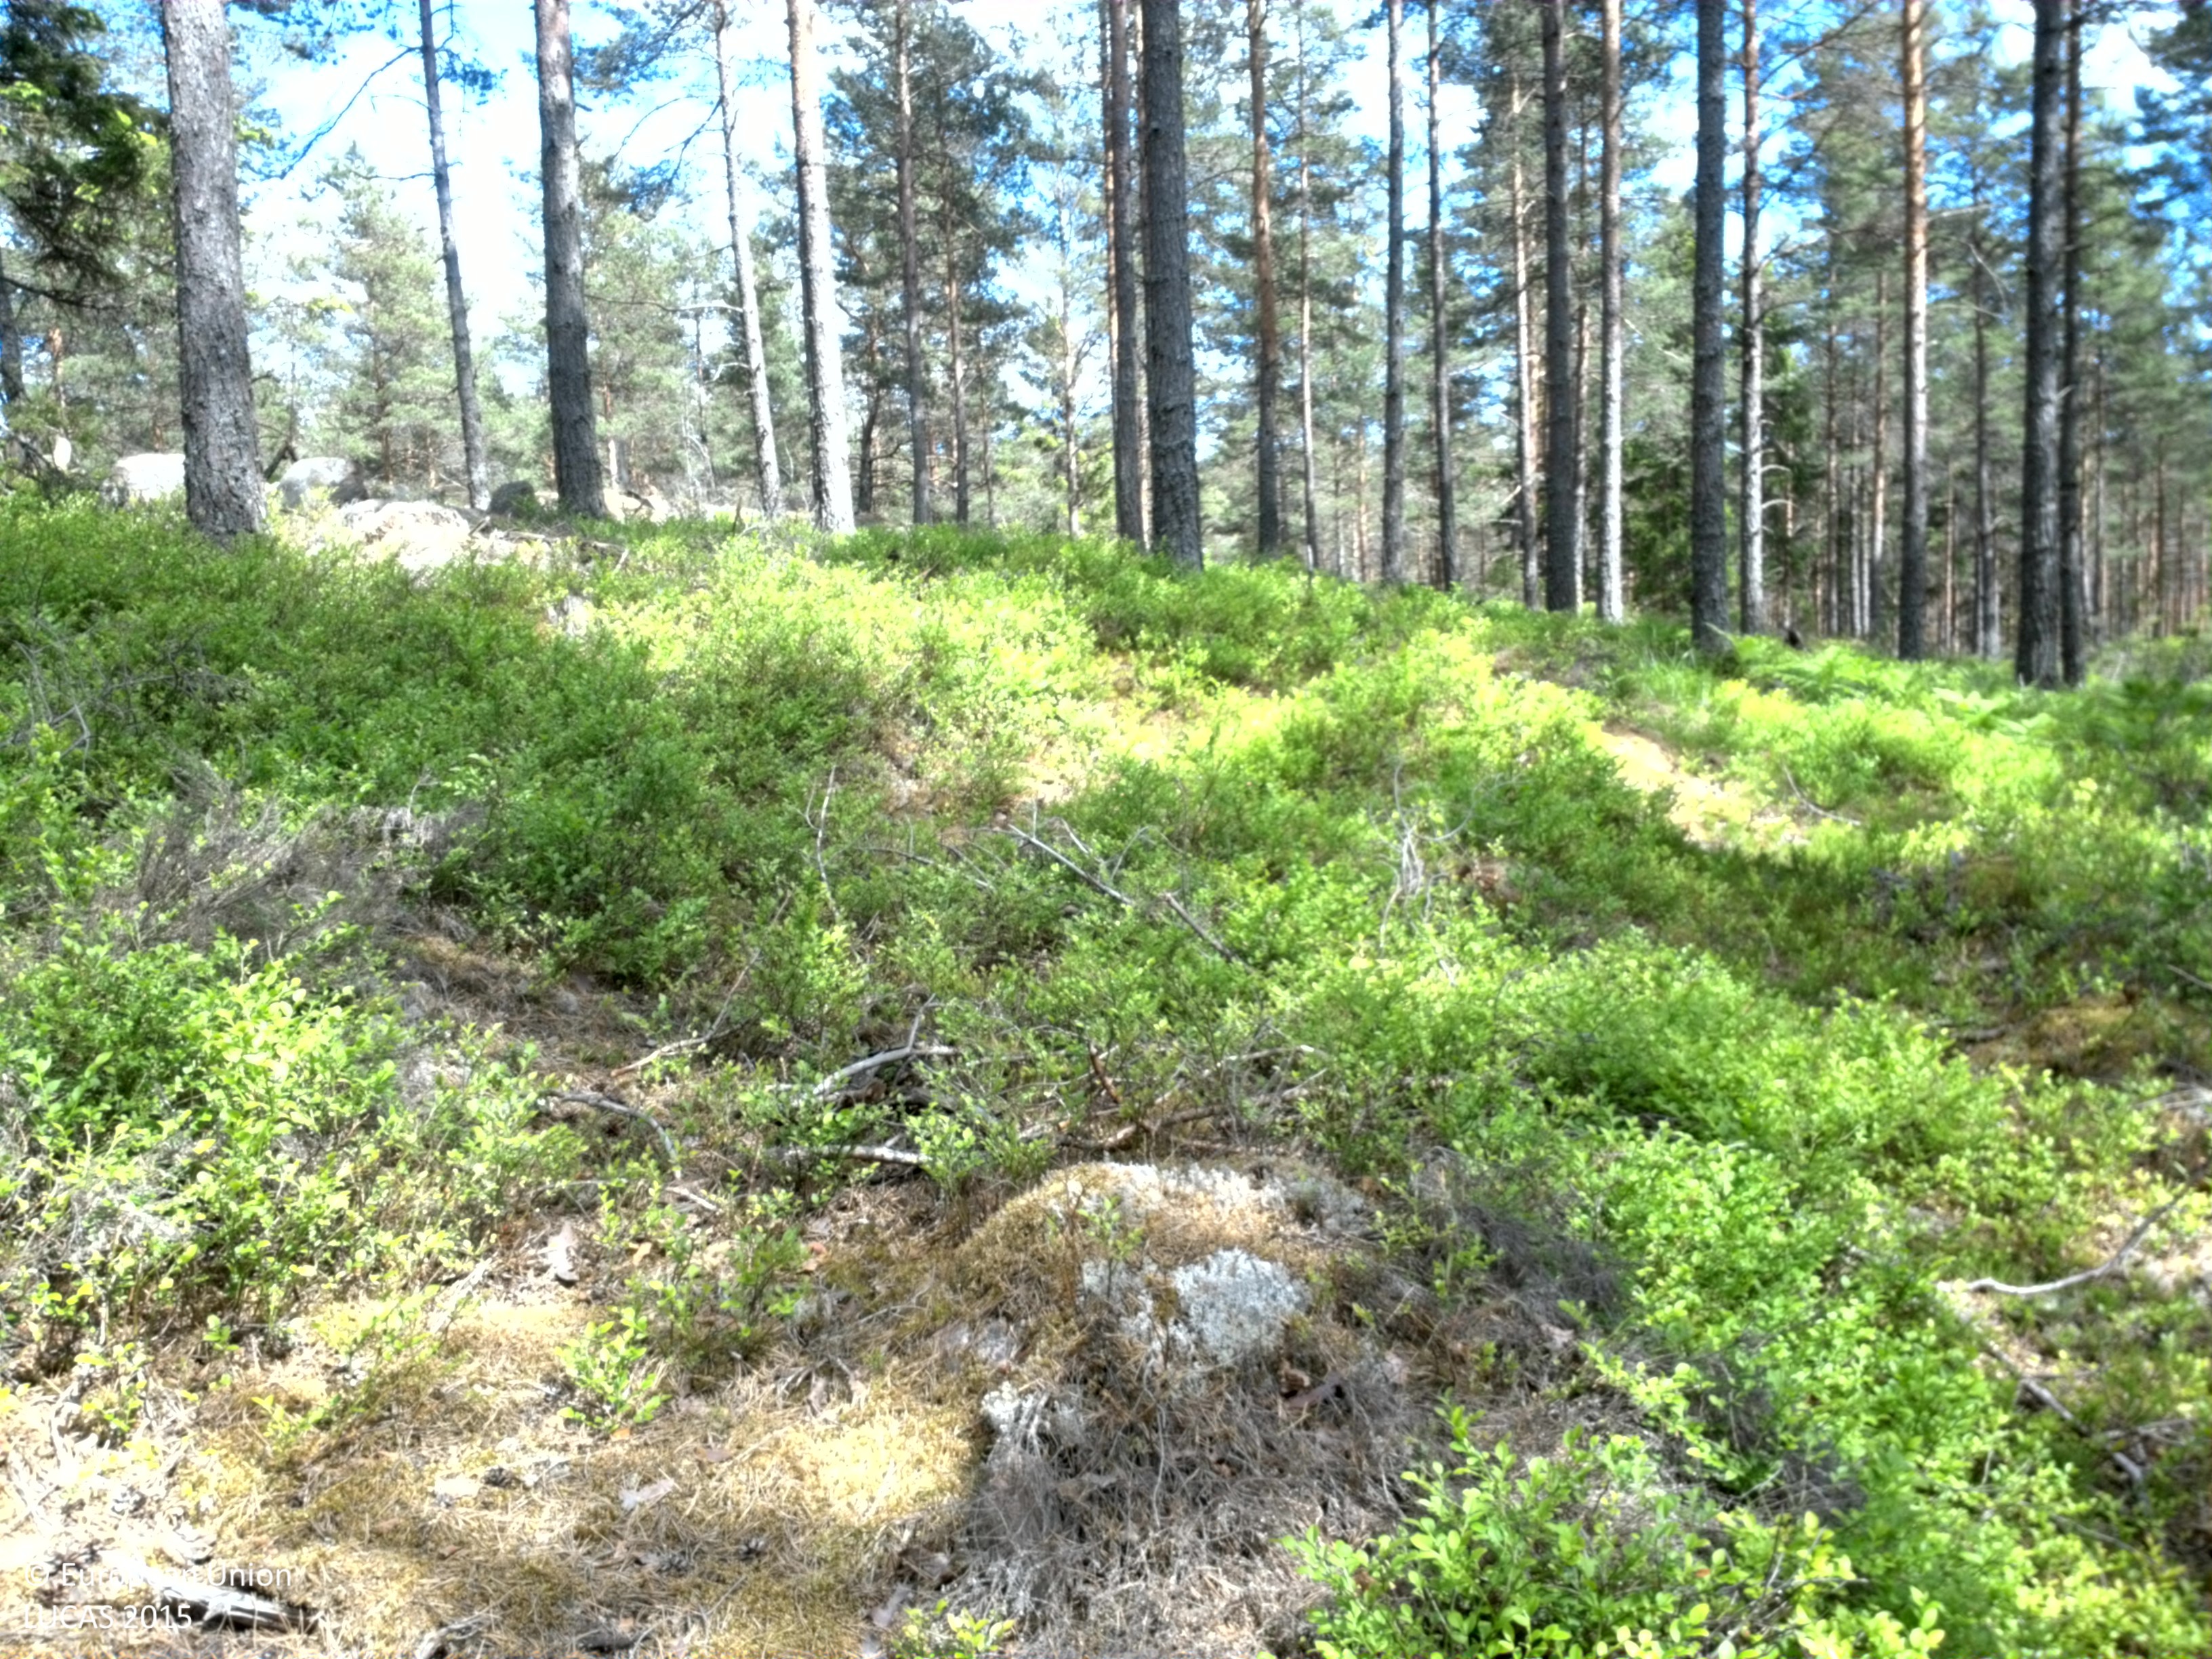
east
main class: Woodland
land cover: Pine dominated coniferous woodland
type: boreal forest
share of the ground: 10 - 25 %
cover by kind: herbaceous plants 40 %, lichens and mosses 40 %, coniferous forest trees 20 %
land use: Forestry
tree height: > 5 m
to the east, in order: Pine dominated coniferous woodland; Rivers and streams; Pine dominated coniferous woodland
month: June
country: SE
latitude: 58.7038
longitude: 16.2946
